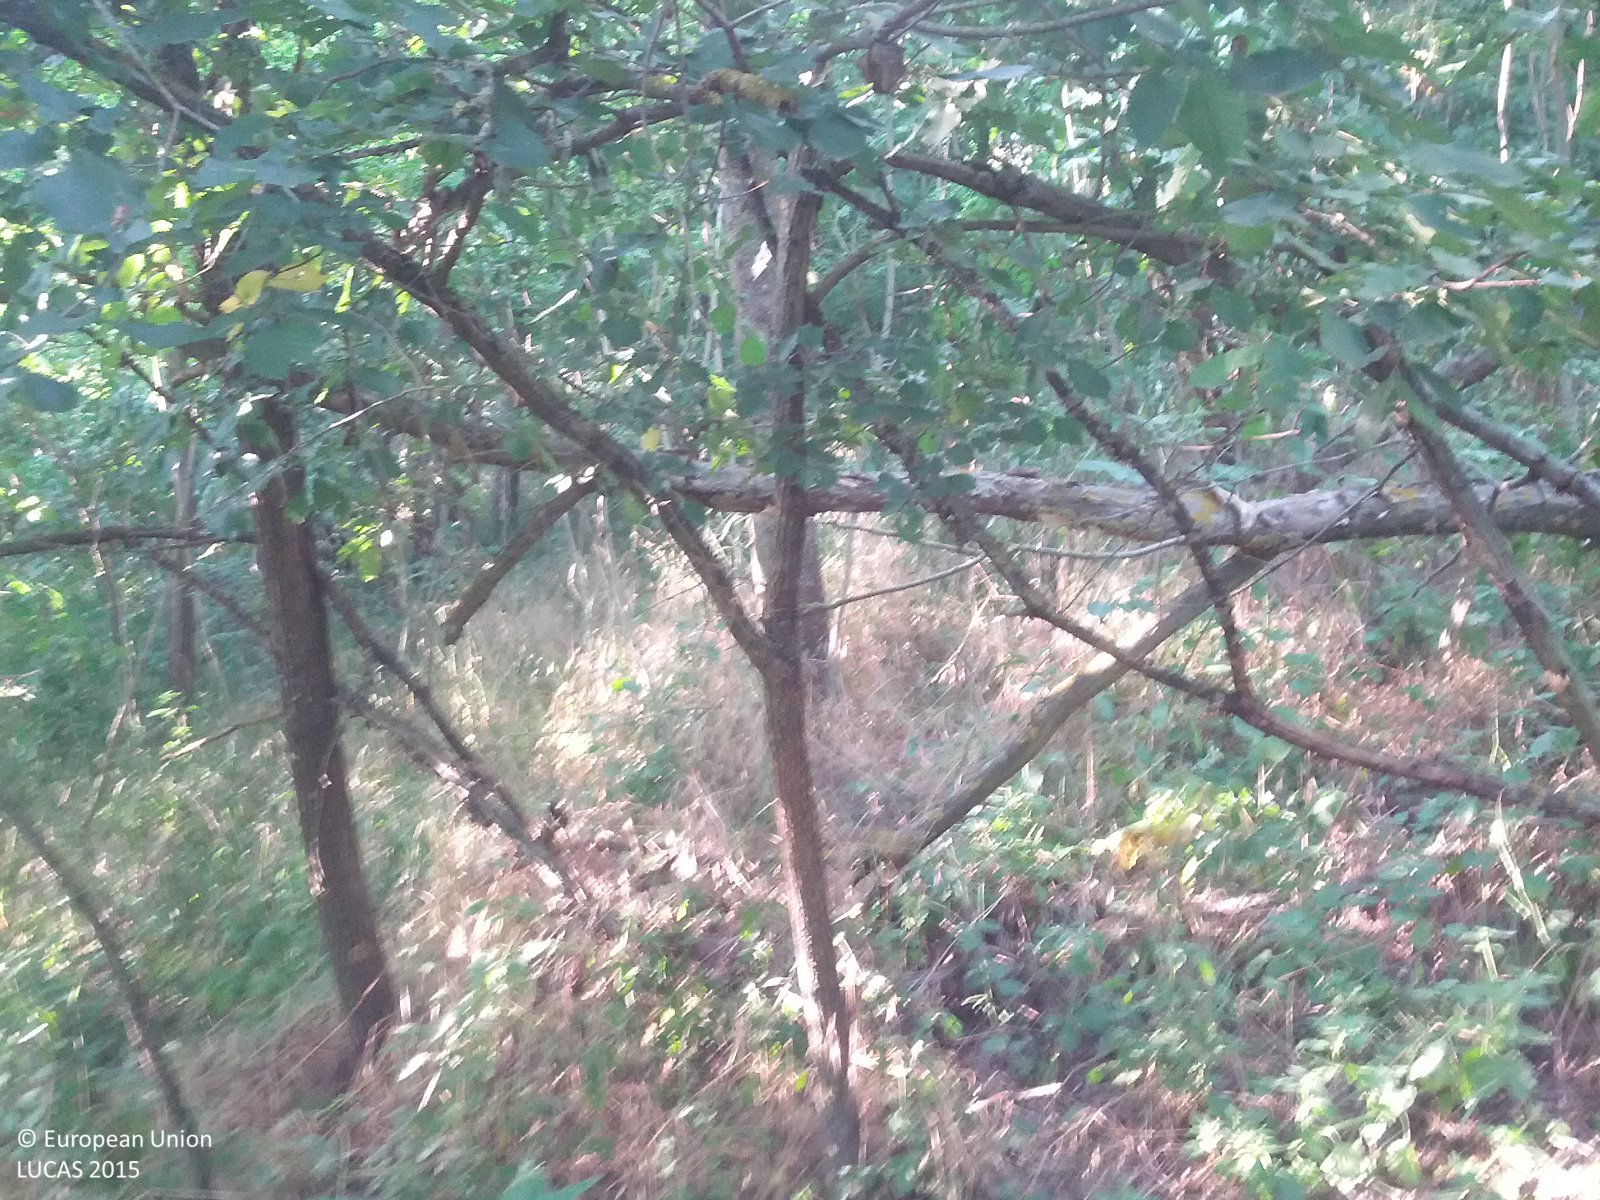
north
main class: Woodland
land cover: Broadleaved woodland
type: mesophytic deciduous forest
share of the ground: > 75 %
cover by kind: broadleaved forest trees 90 %, herbaceous plants 10 %
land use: Forestry
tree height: > 5 m
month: July
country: AT
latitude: 48.3862
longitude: 16.6095
